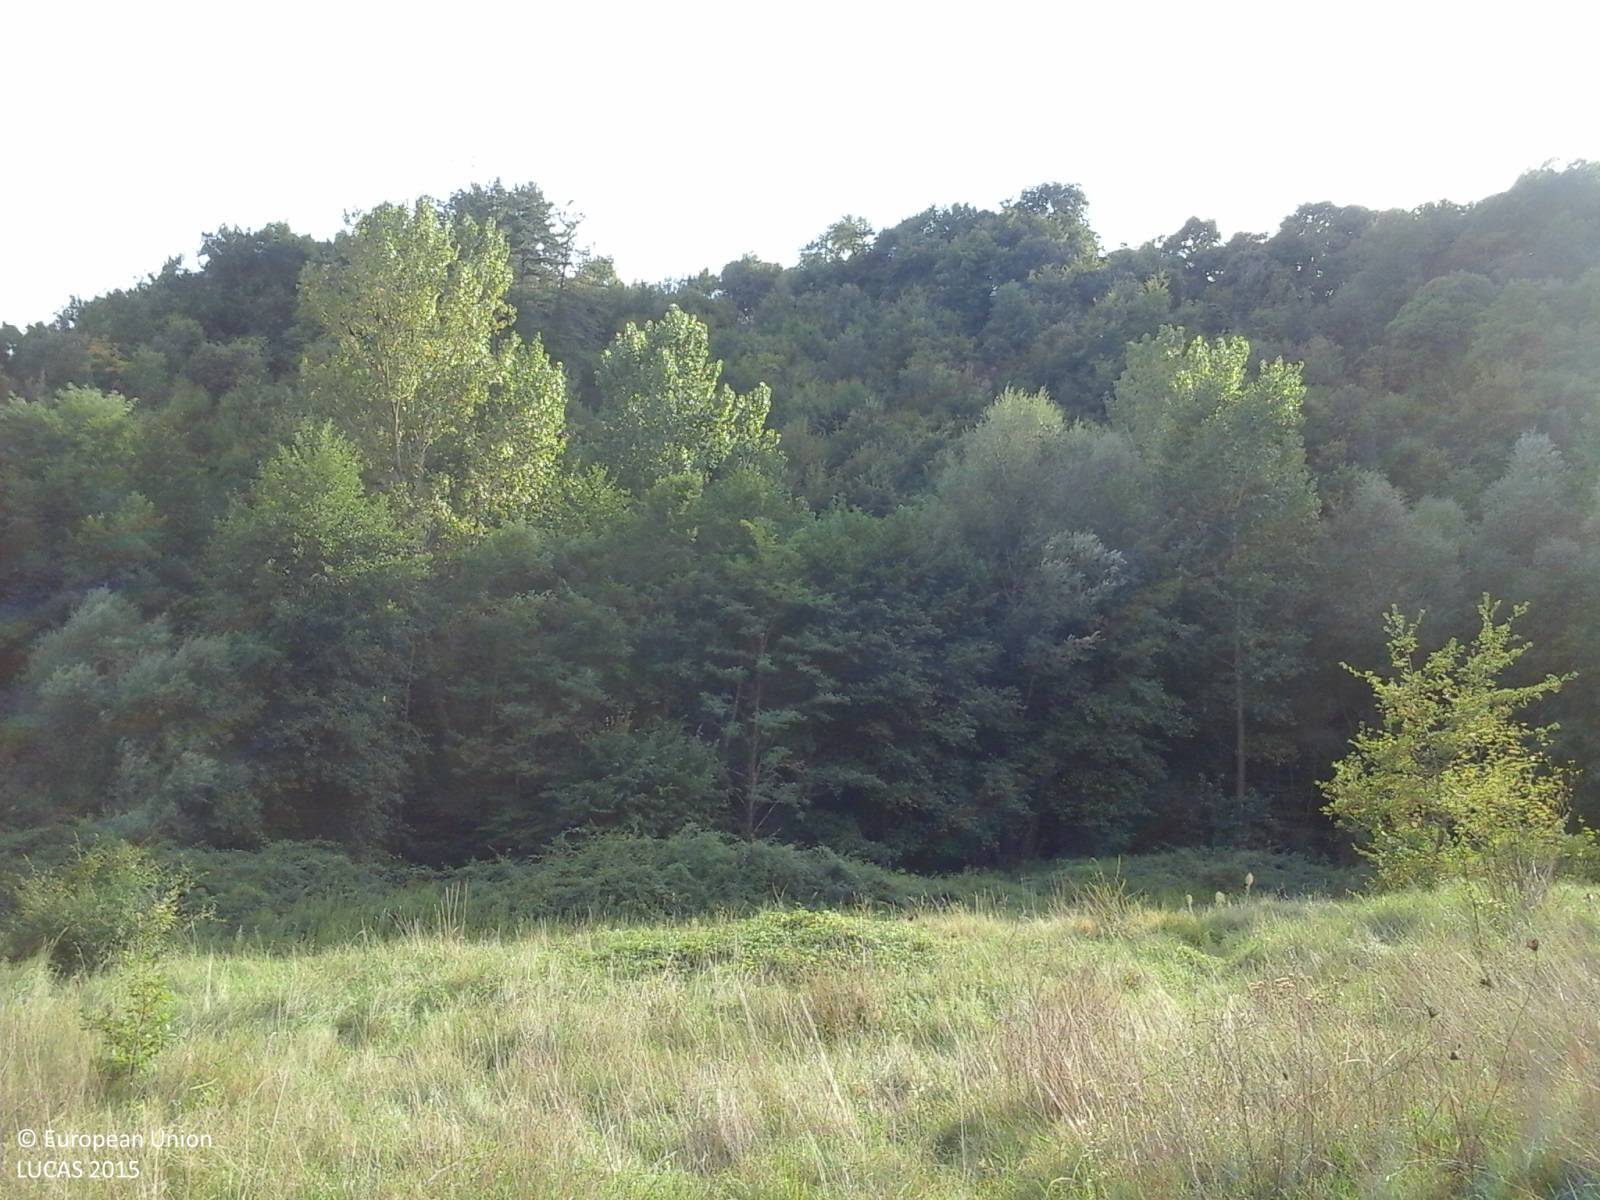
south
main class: Woodland
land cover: Broadleaved woodland
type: thermophilous deciduous forest
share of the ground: > 75 %
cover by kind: broadleaved forest trees 85 %, shrubs 15 %
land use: Forestry
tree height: > 5 m
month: September
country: IT
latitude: 42.7766
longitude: 12.1078
